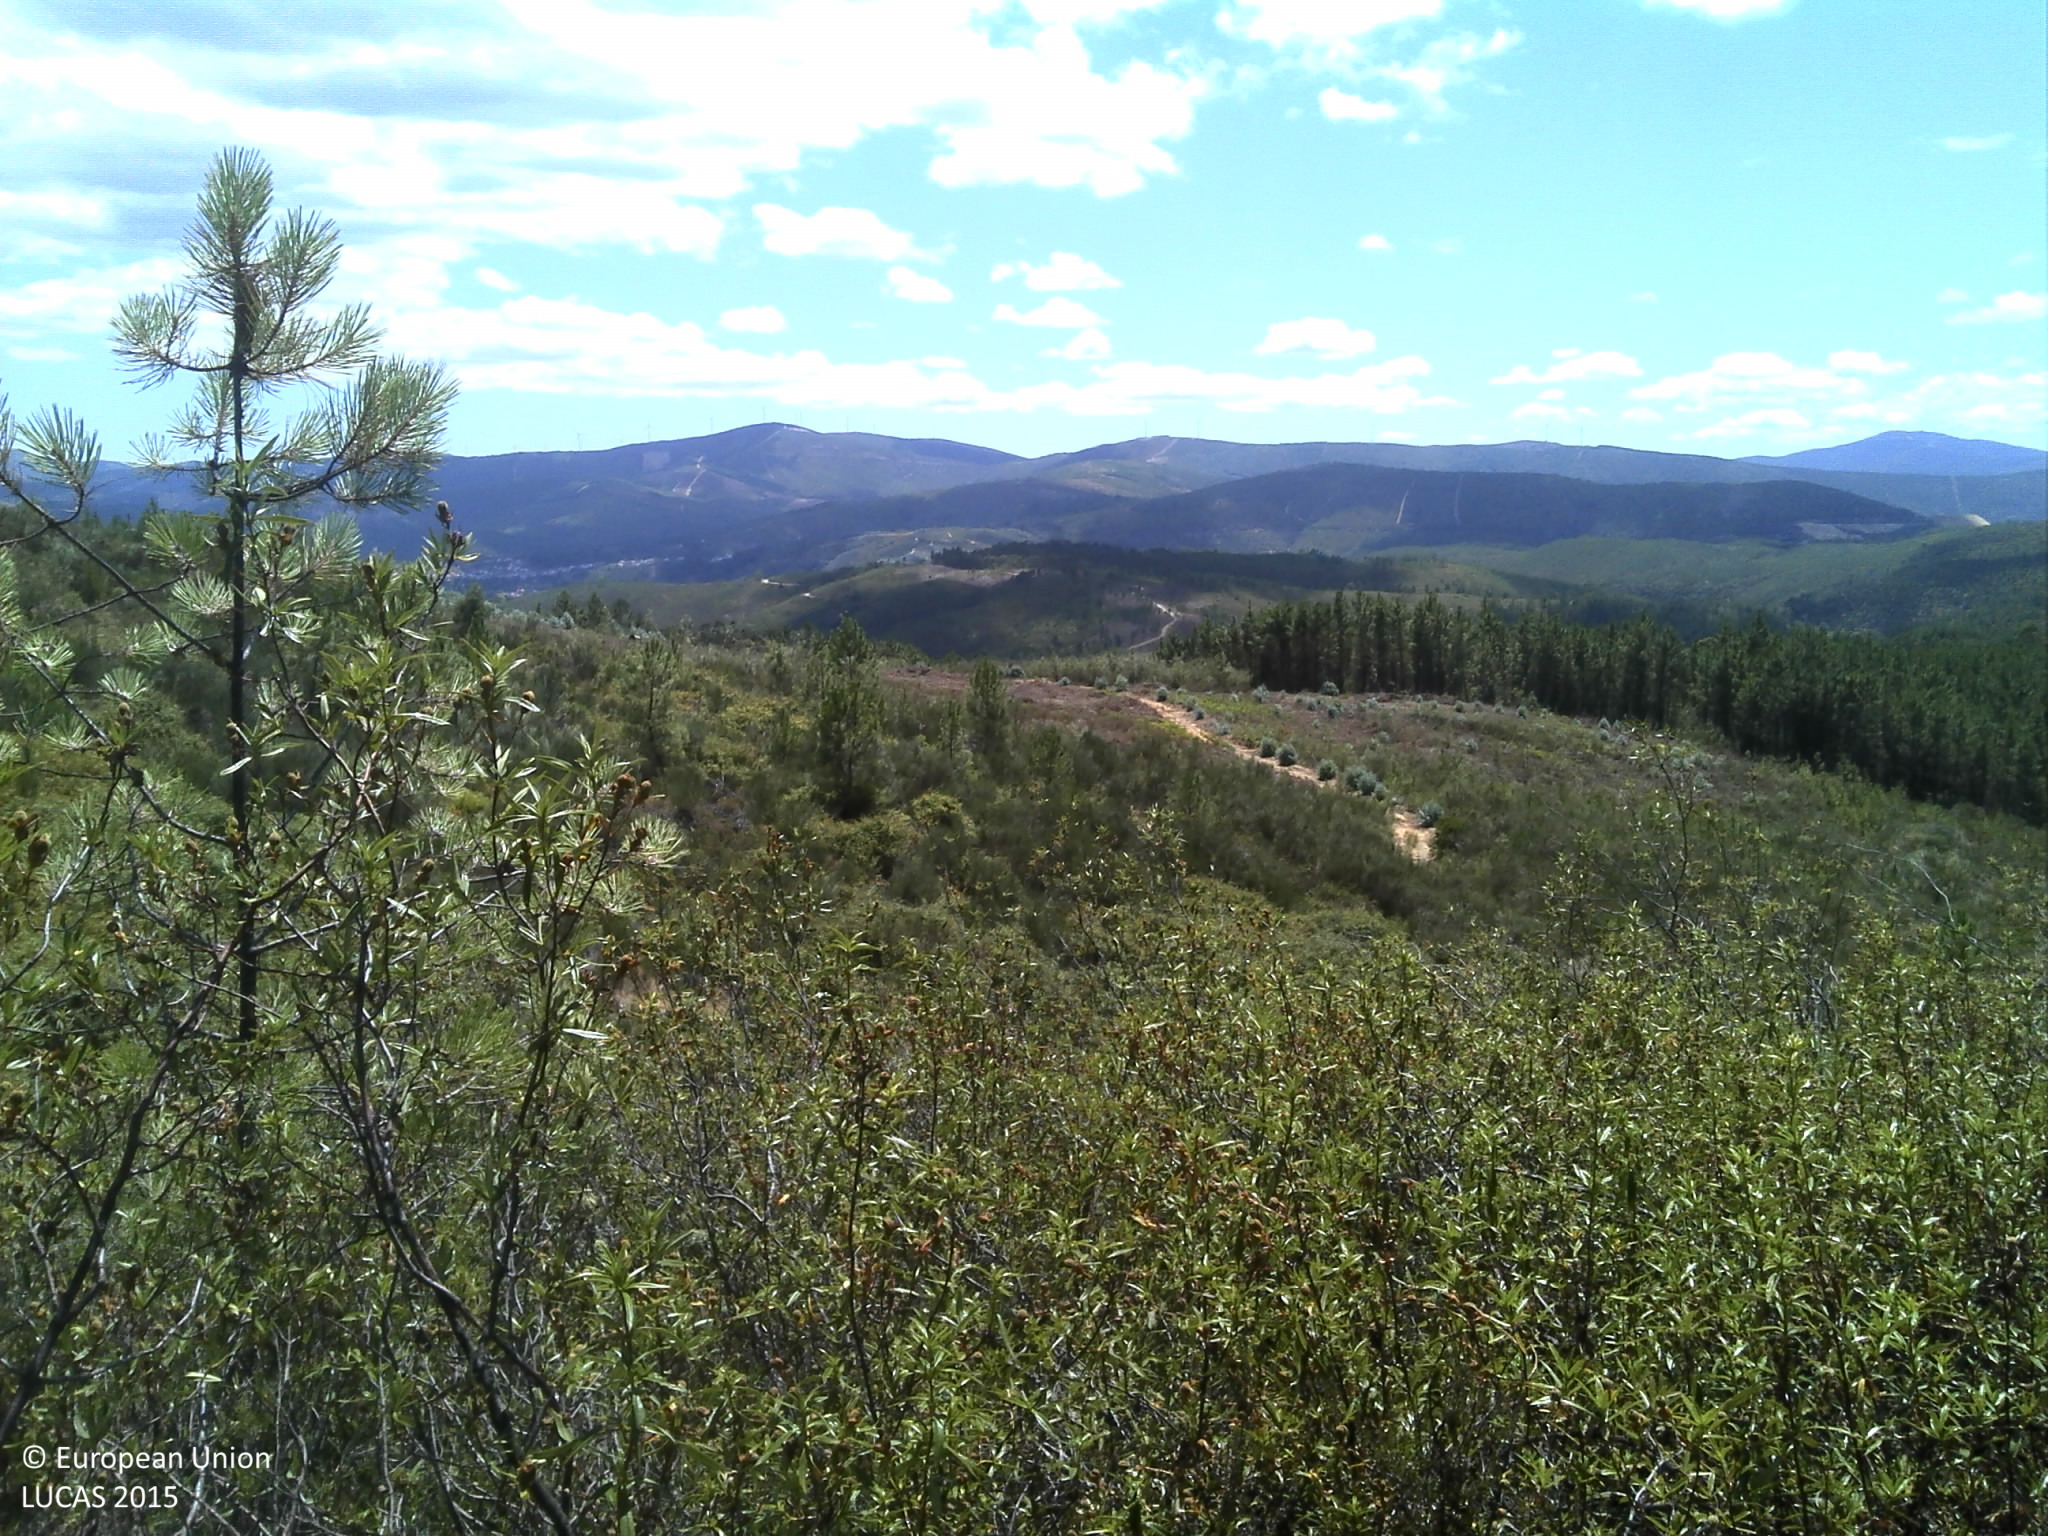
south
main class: Shrubland
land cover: Shrubland with sparse tree cover
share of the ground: 50 - 75 %
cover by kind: shrubs 85 %, coniferous forest trees 5 %, unconsolidated bare surface 5 %
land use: Abandoned areas
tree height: < 5 m
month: July
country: PT
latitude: 40.1737
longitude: -7.7136
